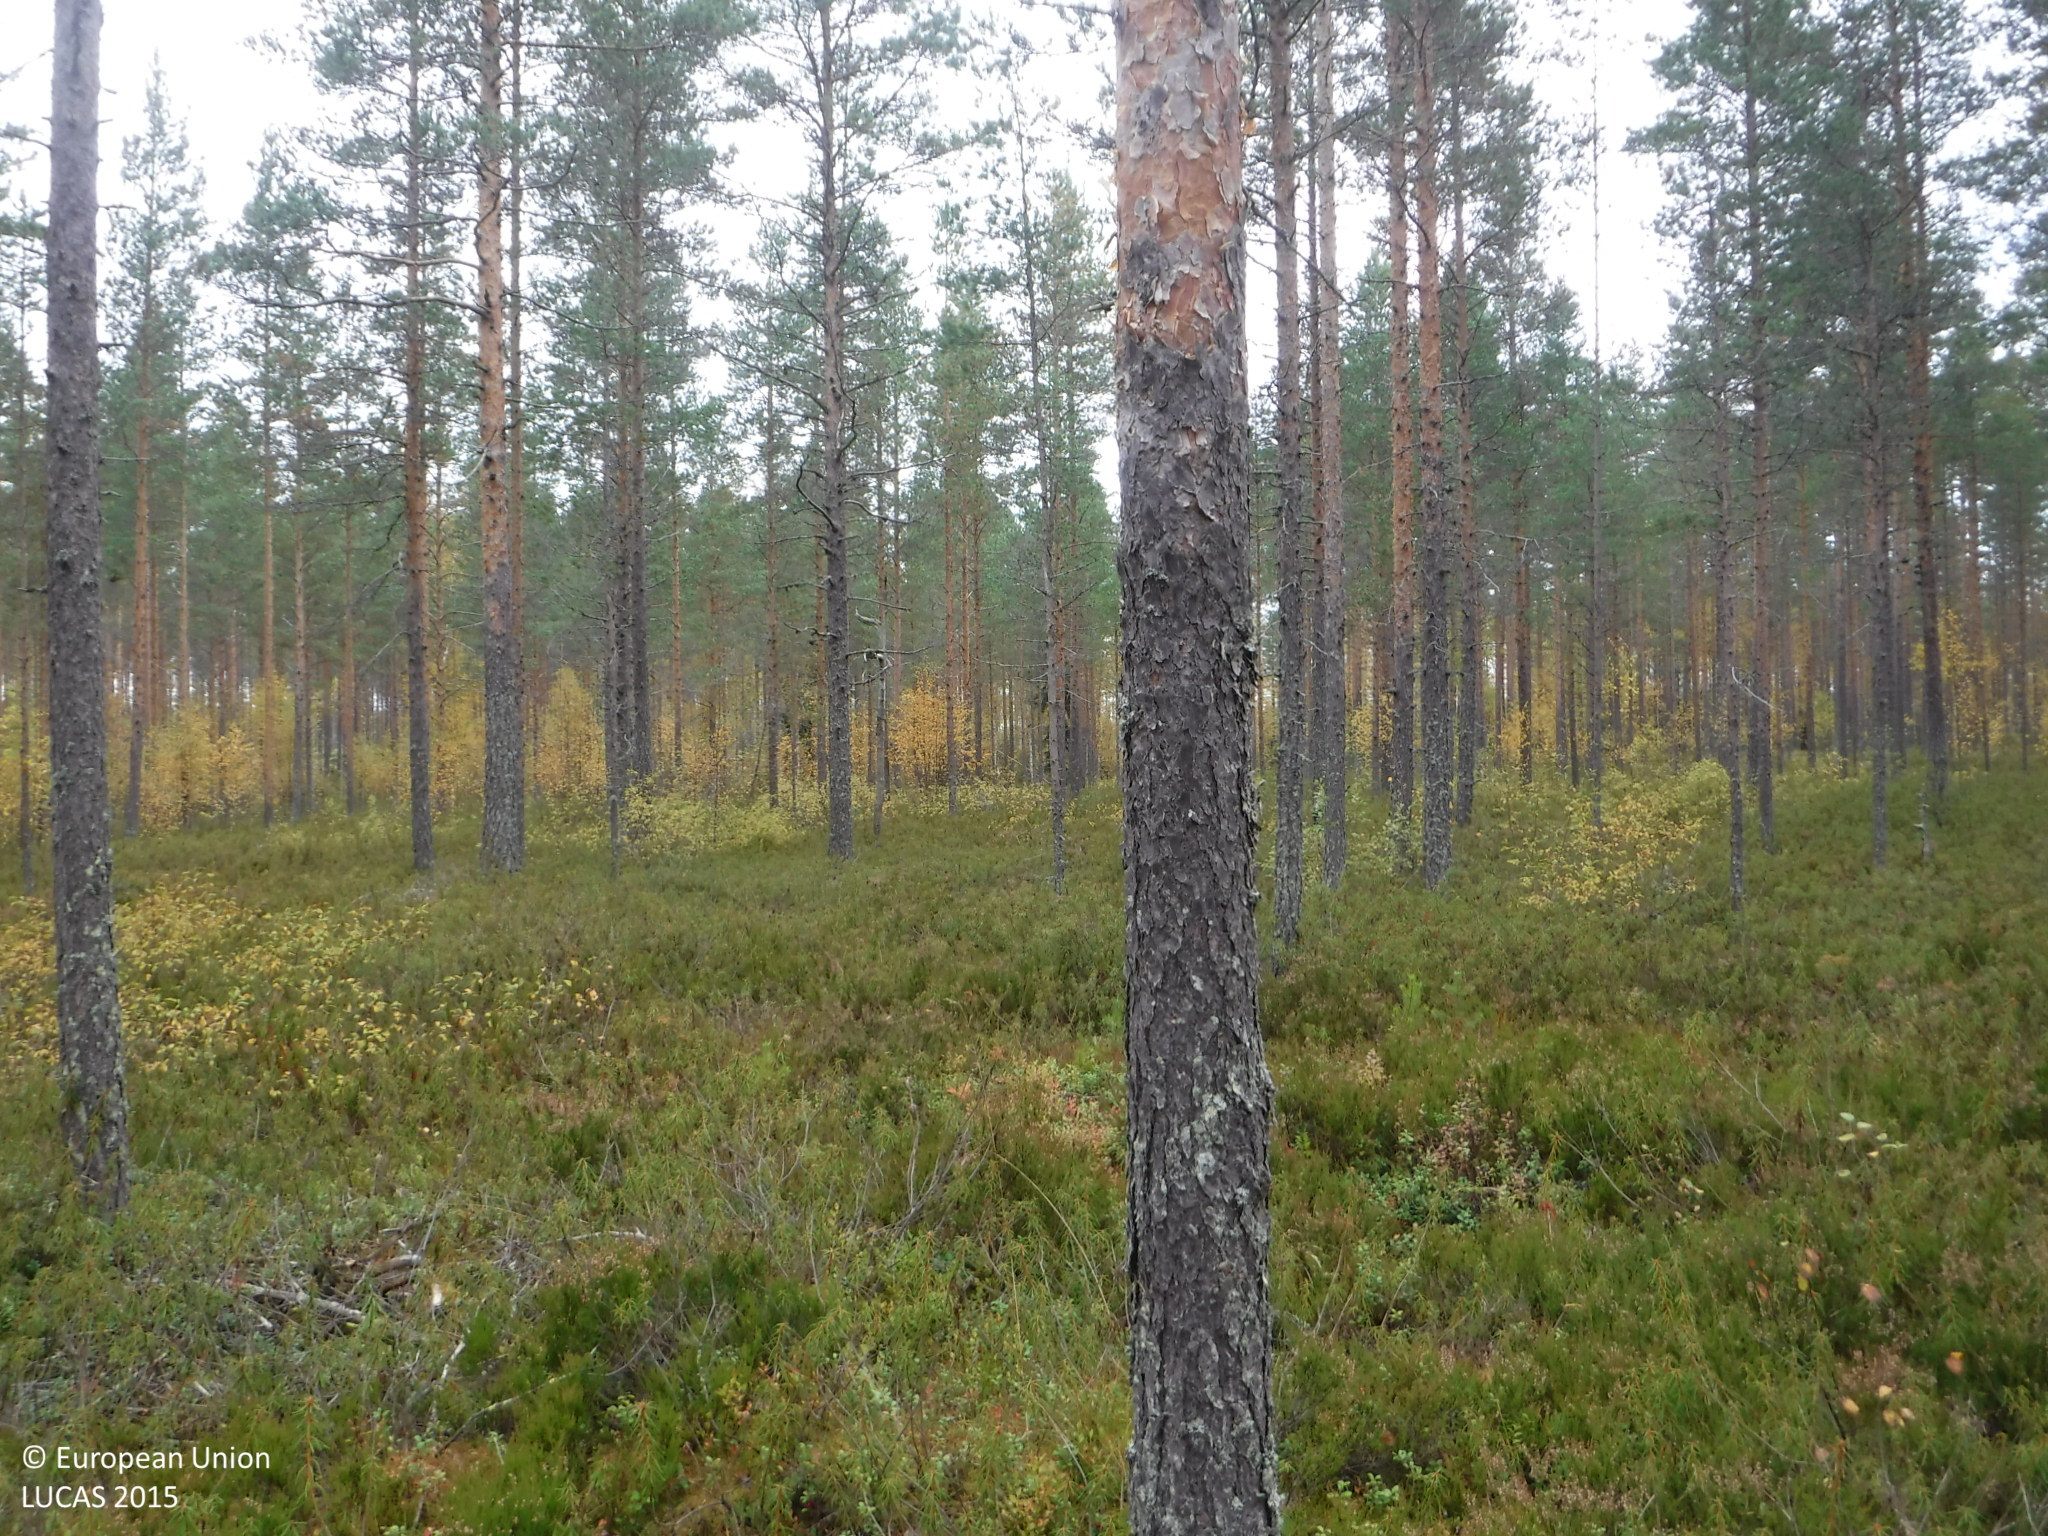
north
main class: Woodland
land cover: Pine dominated coniferous woodland
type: boreal forest
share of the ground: 25 - 50 %
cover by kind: shrubs 50 %, coniferous forest trees 30 %, lichens and mosses 20 %
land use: Forestry
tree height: > 5 m
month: September
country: FI
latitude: 62.0866
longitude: 22.9524
